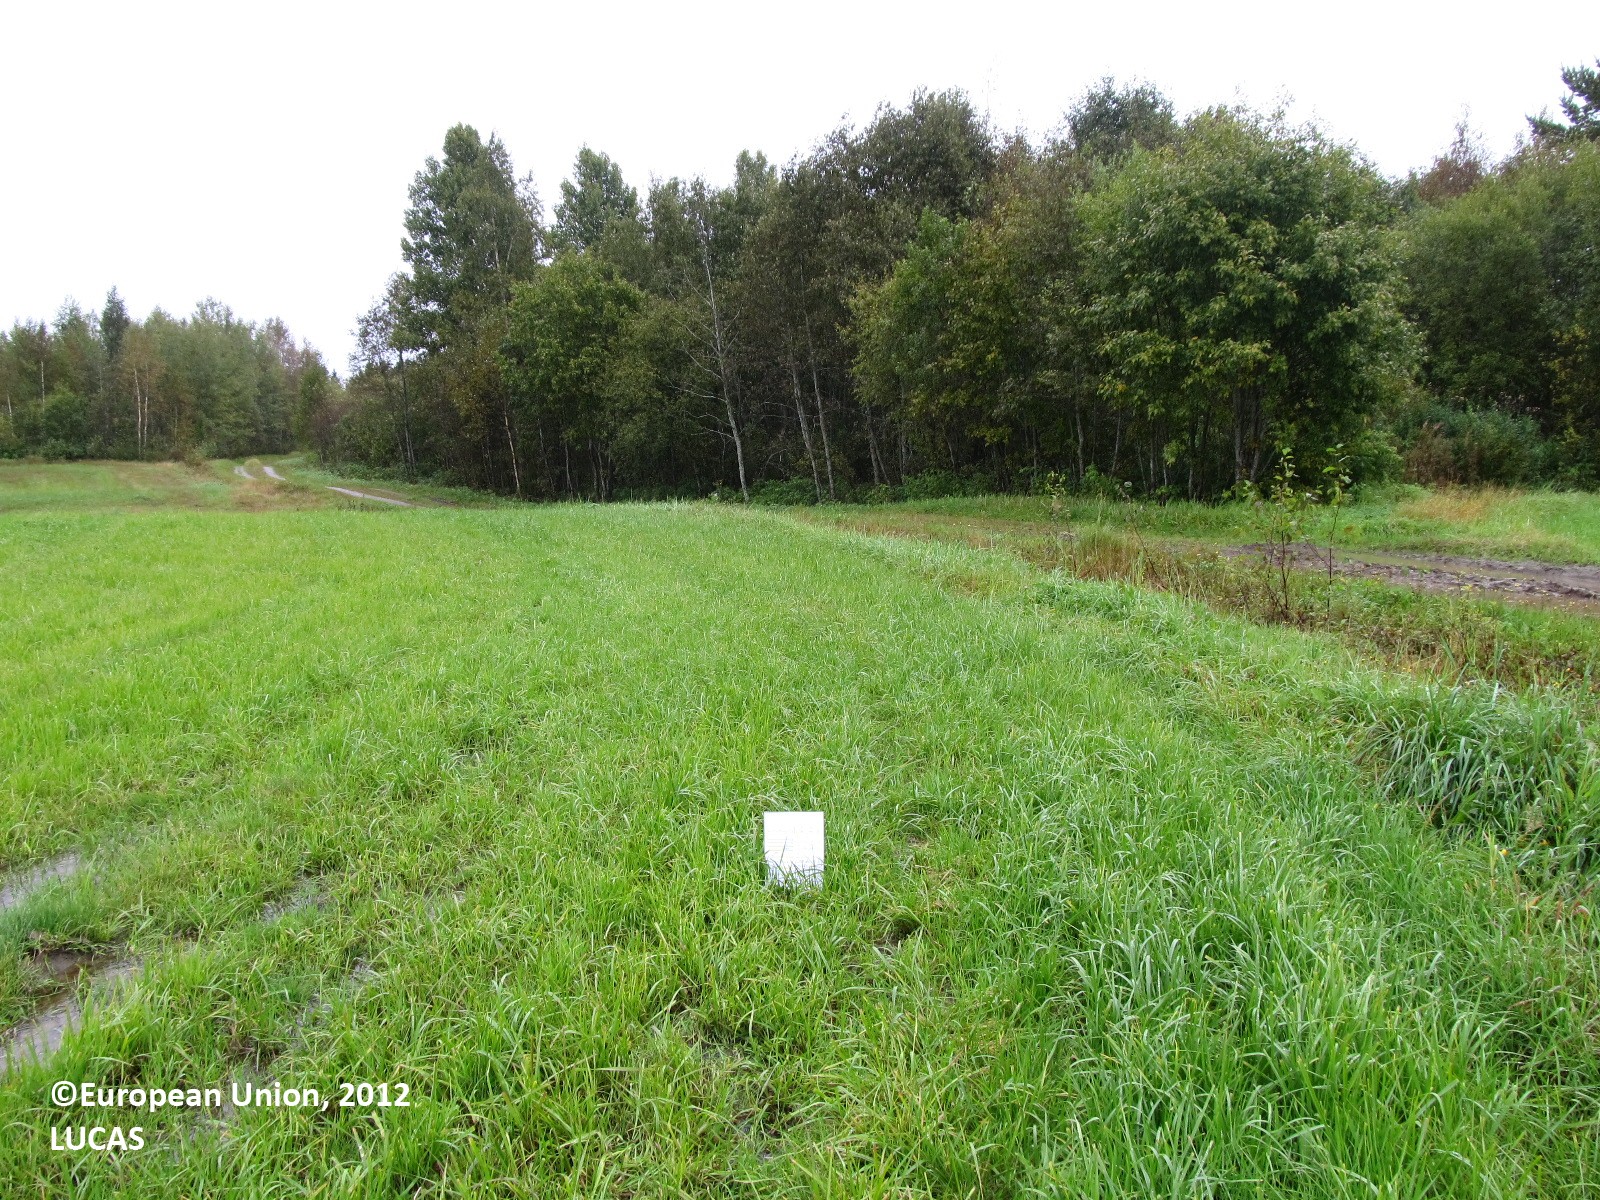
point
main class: Cropland
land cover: Temporary grasslands
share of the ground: > 75 %
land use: Agriculture (excluding fallow land and kitchen gardens)
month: September
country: FI
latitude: 63.1477
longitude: 28.0165
